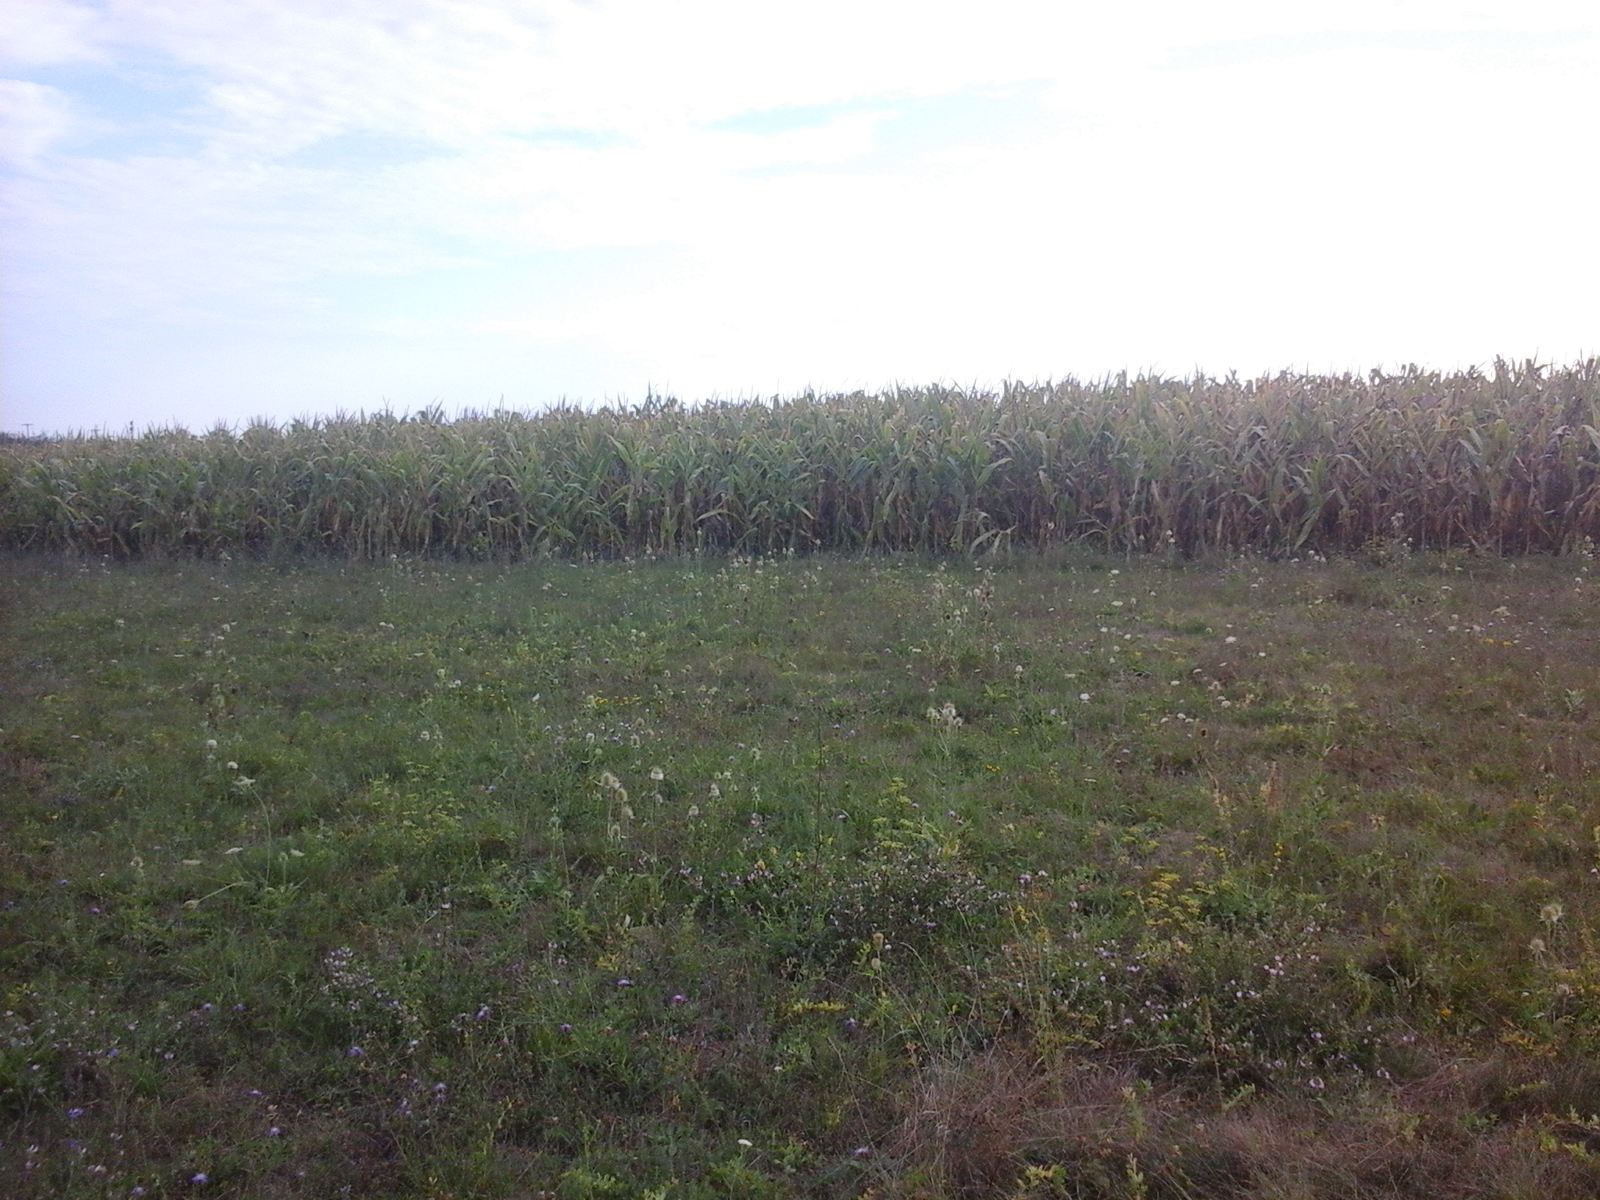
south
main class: Grassland
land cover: Grassland without tree/shrub cover
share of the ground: > 75 %
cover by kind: herbaceous plants 100 %
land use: Agriculture (excluding fallow land and kitchen gardens)
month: August
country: RO
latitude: 46.7366
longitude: 21.5961
